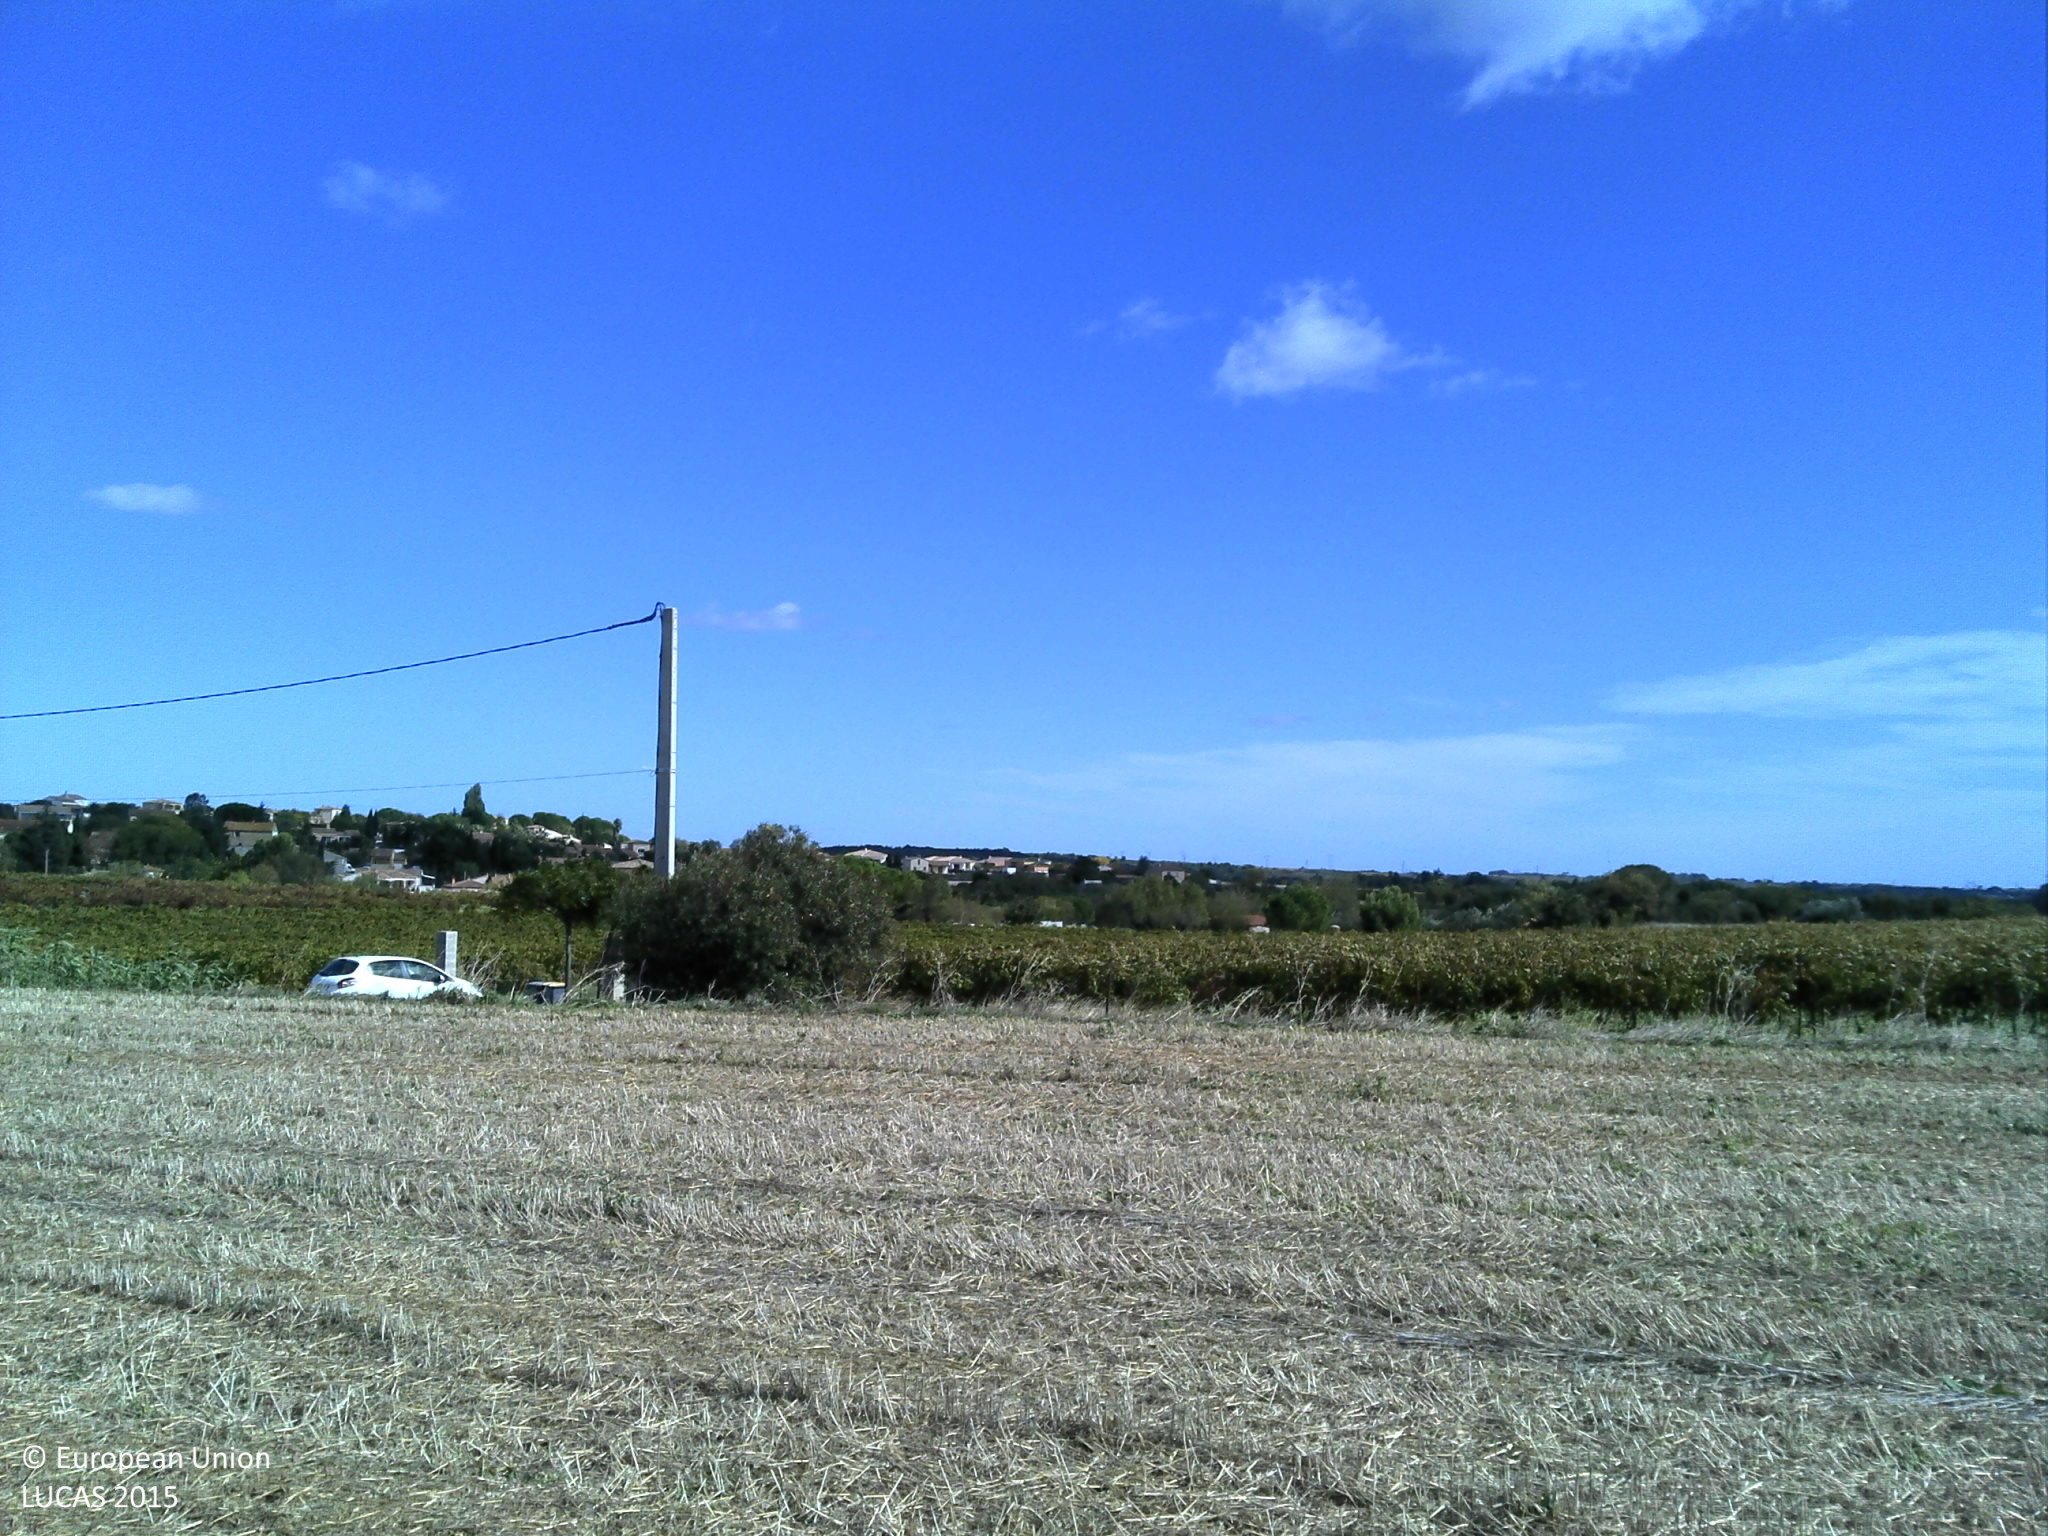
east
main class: Cropland
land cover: Common wheat
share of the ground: 25 - 50 %
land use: Agriculture (excluding fallow land and kitchen gardens)
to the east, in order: Common wheat; Grass margins; Paved roads, cycling and walking lanes; Grassland with sparse tree/shrub cover; Vineyards; Tracks; Managed hedges; Fences; Grassland without tree/shrub cover; Vineyards; Fences; Abandoned hedges; Olive groves
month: October
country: FR
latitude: 43.4166
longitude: 3.4019
